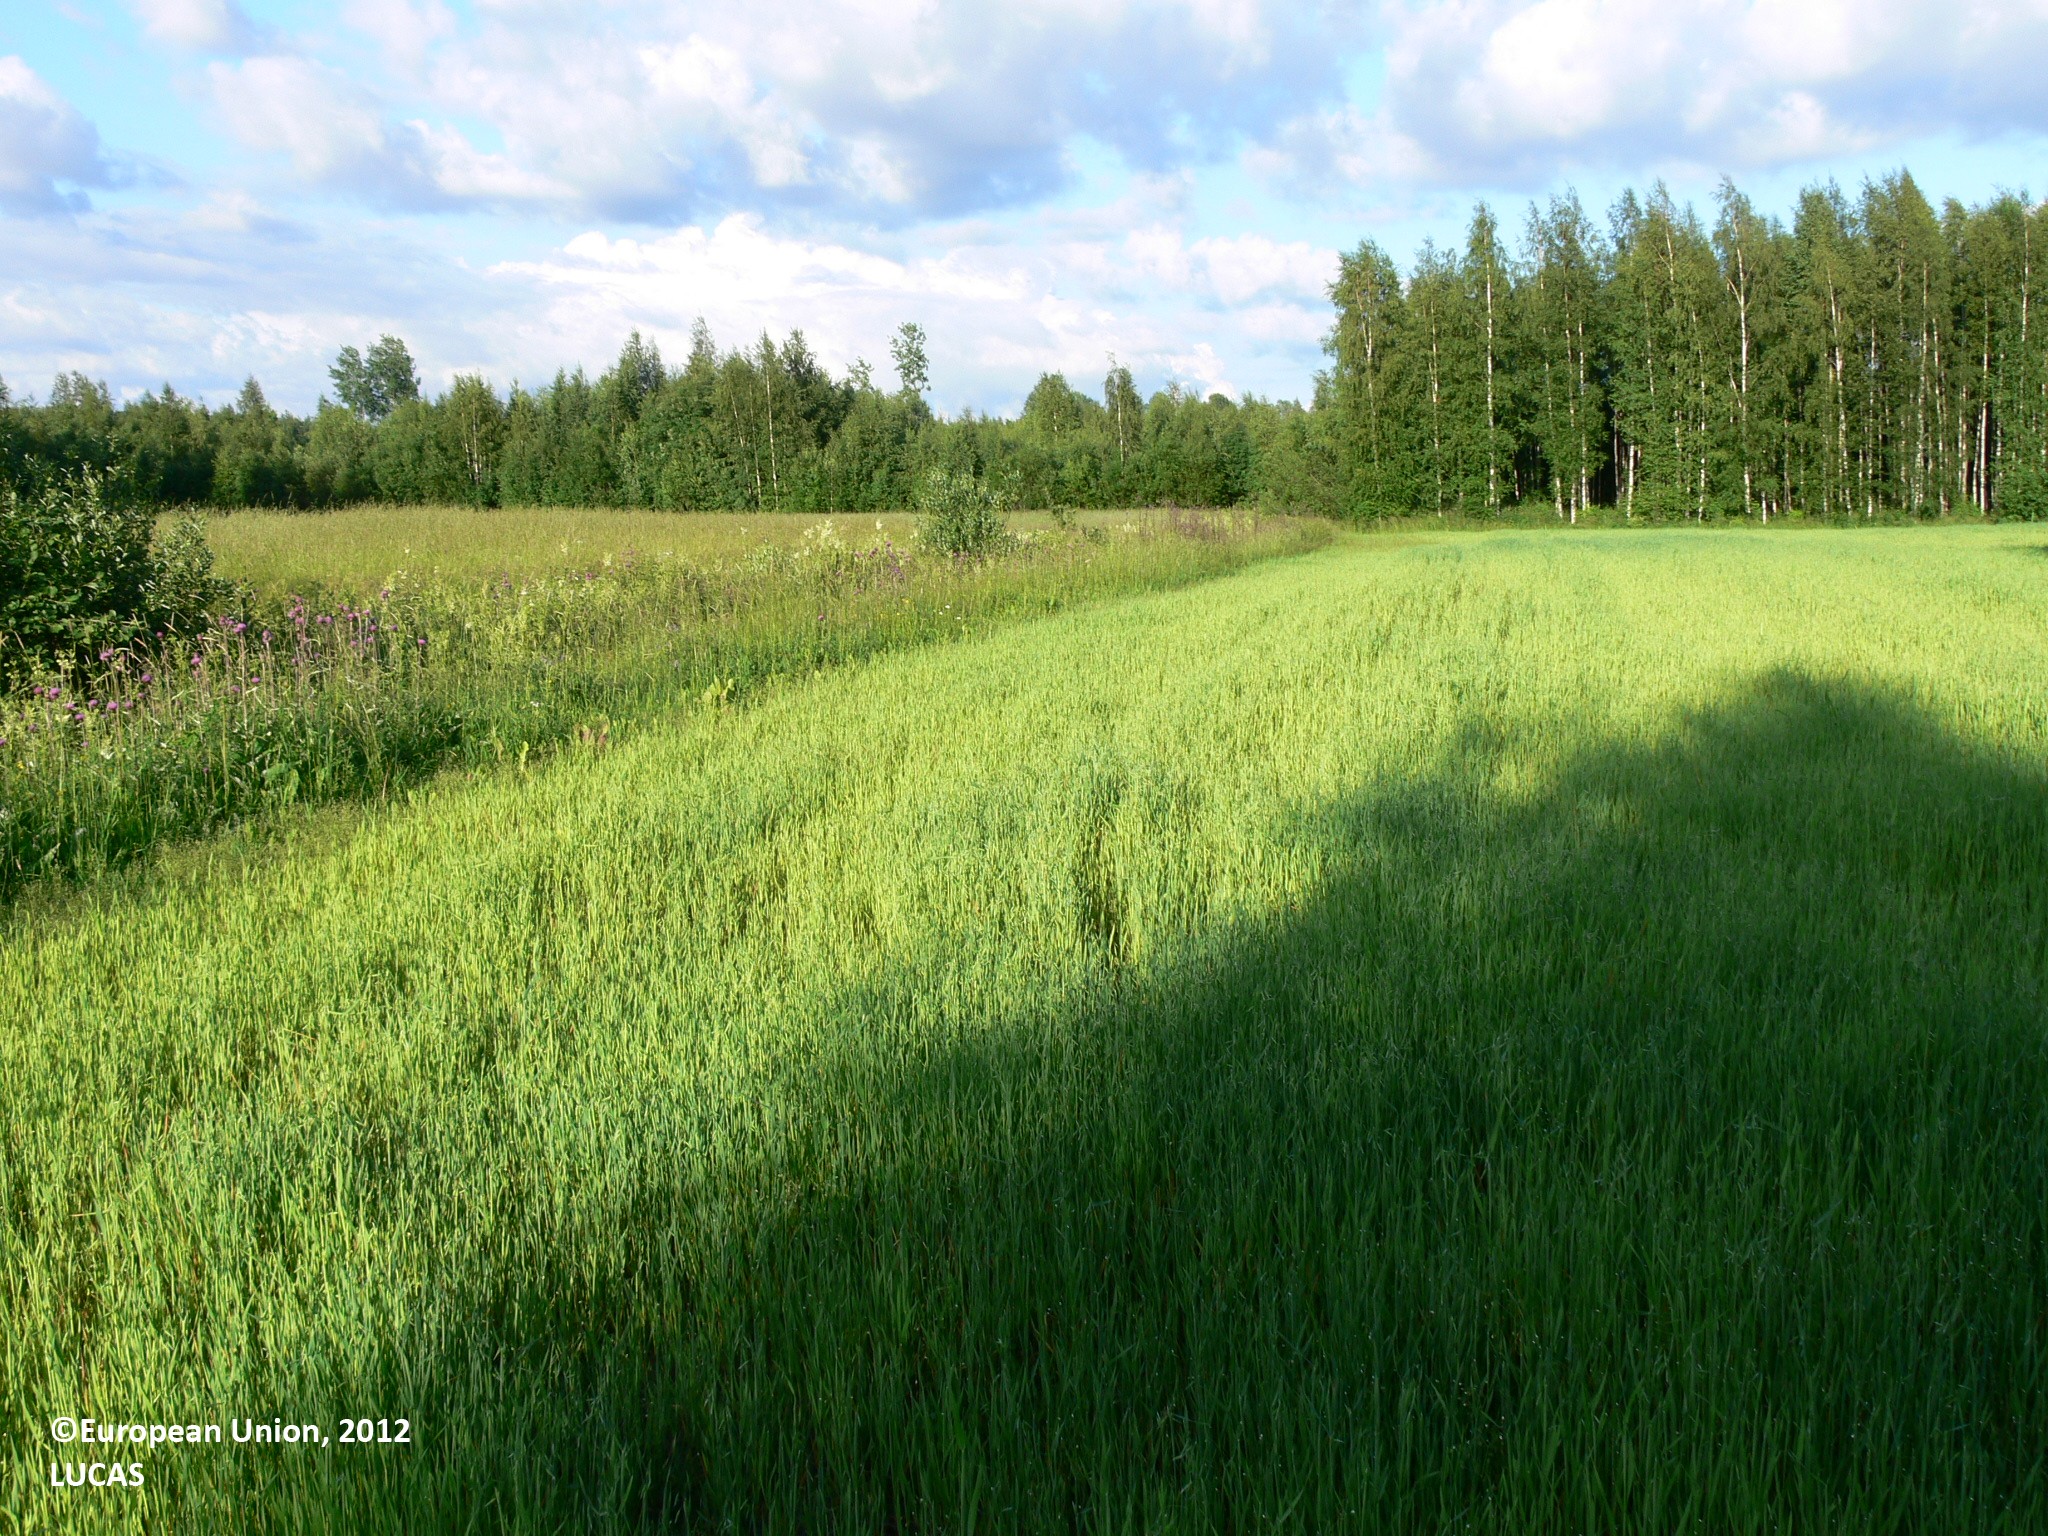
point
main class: Cropland
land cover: Oats
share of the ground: > 75 %
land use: Agriculture (excluding fallow land and kitchen gardens)
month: July
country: FI
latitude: 62.3027
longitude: 29.3876
